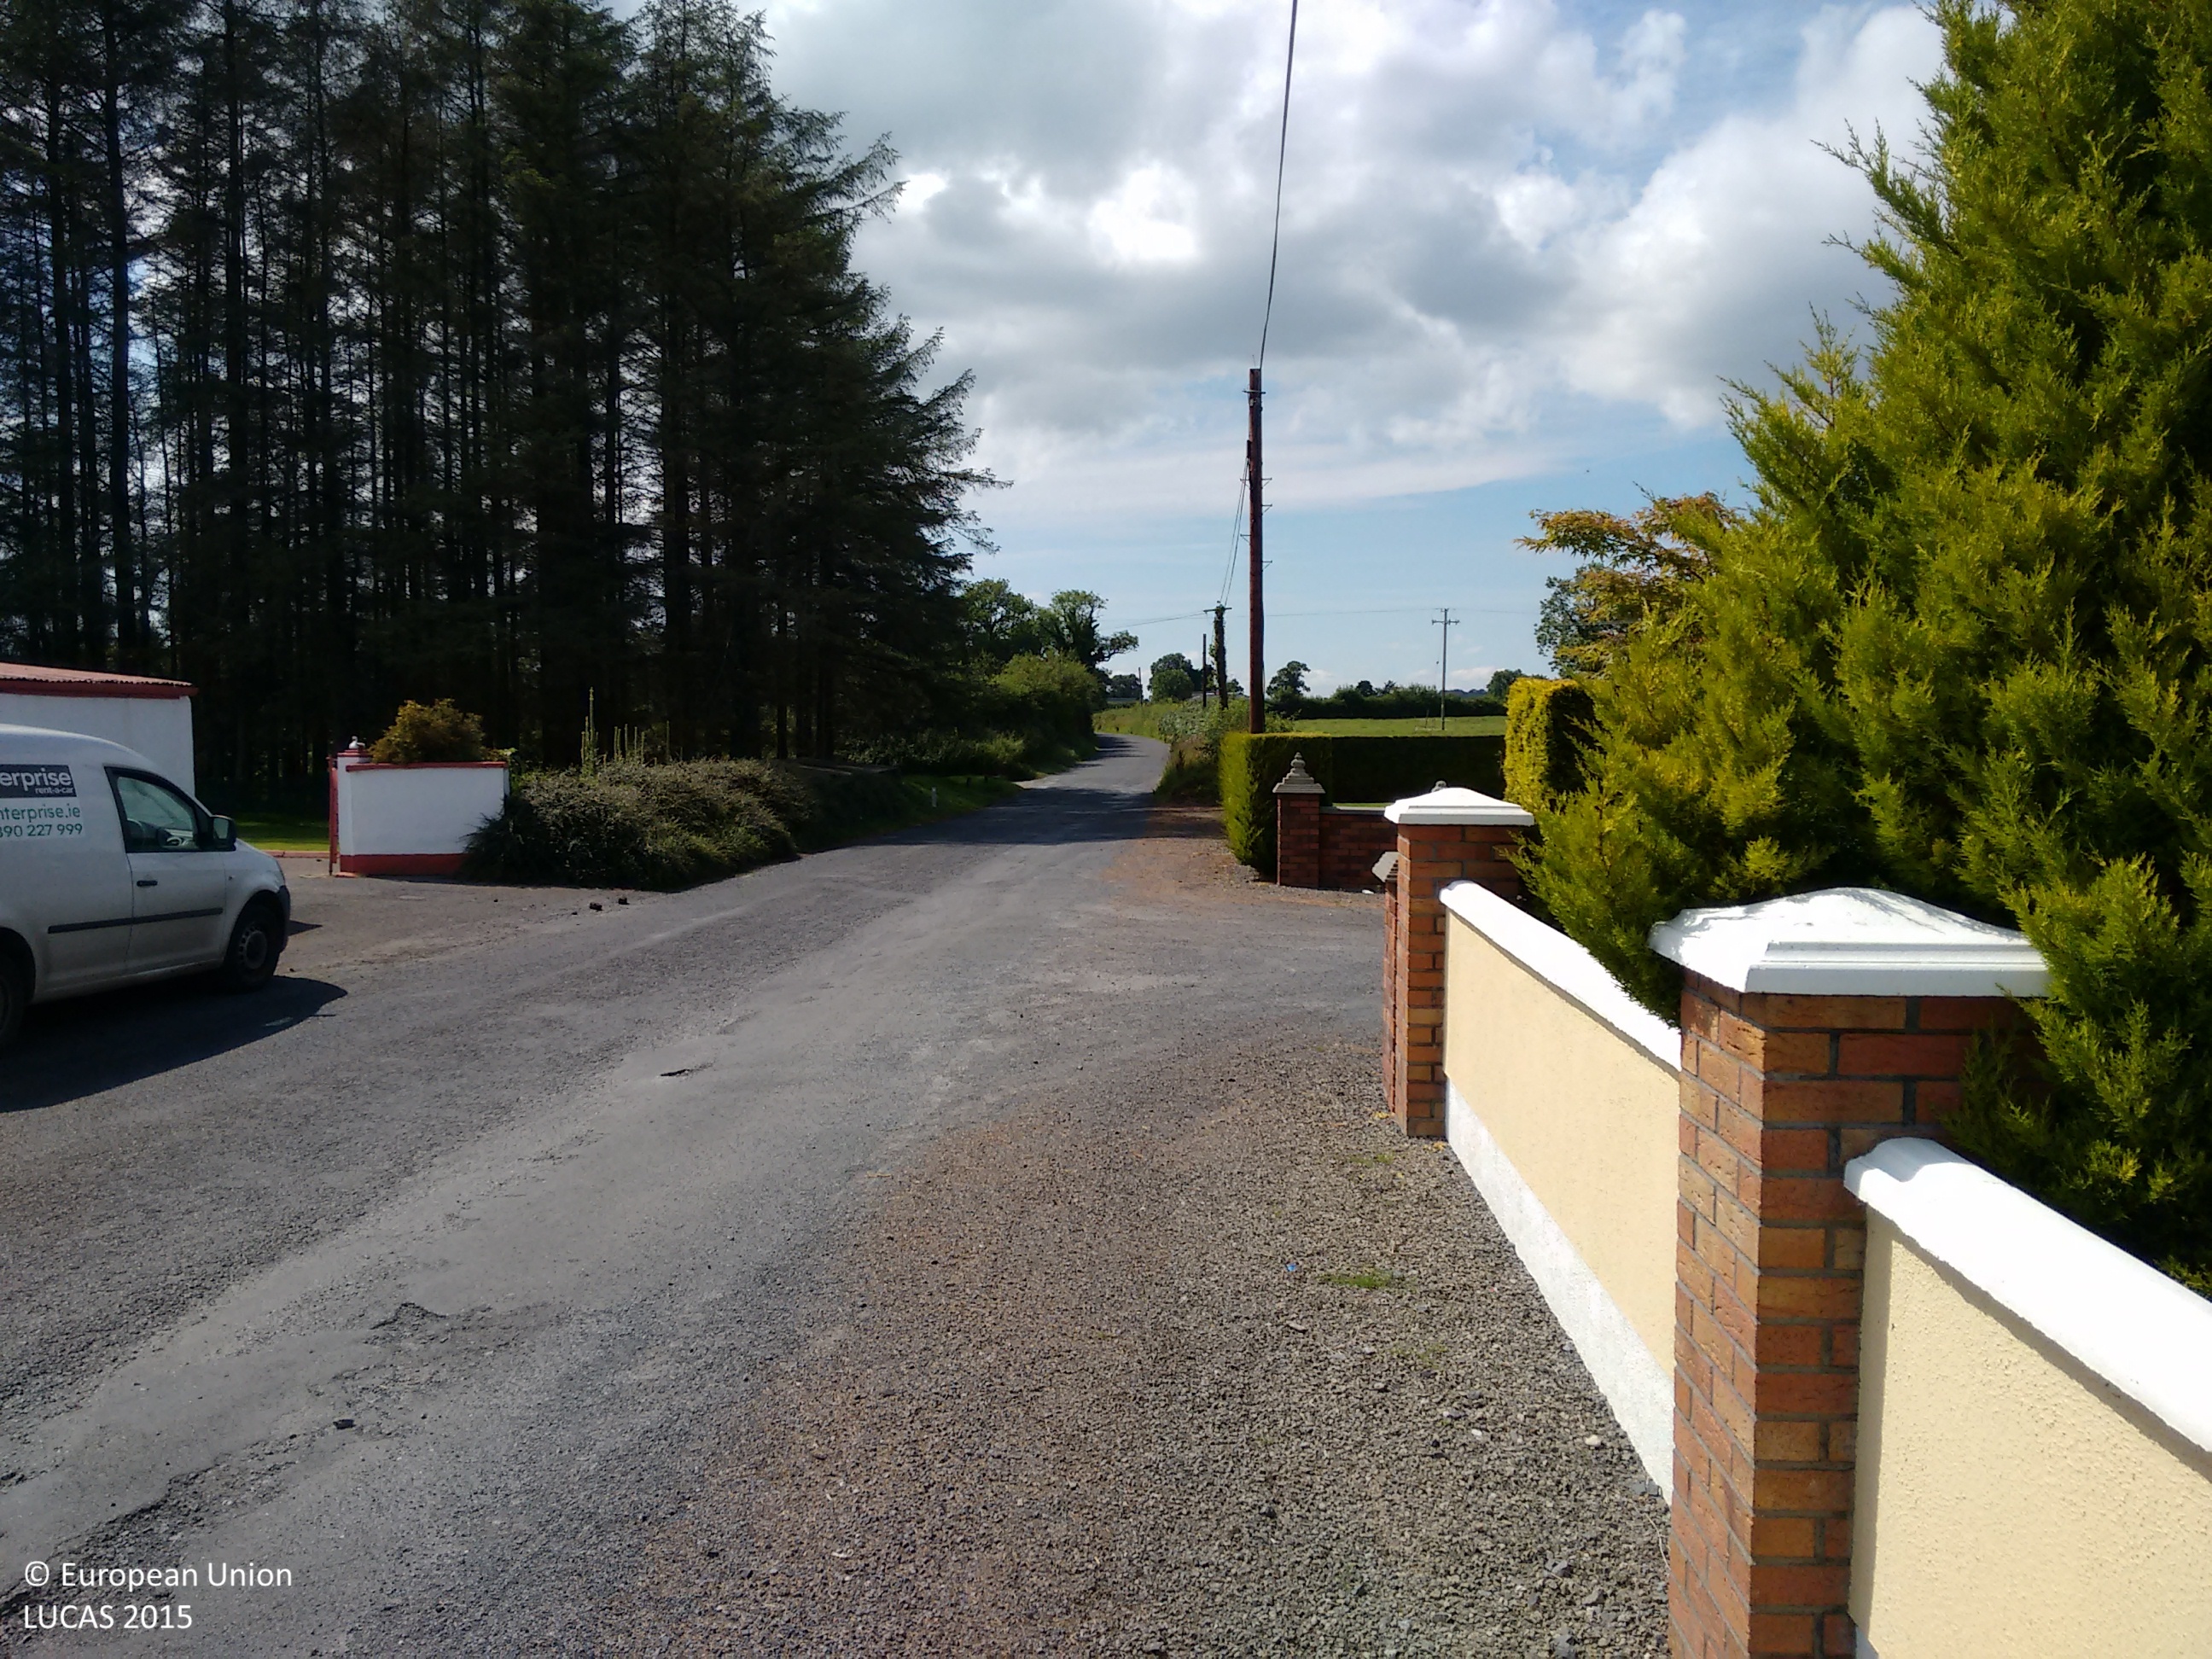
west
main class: Grassland
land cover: Grassland with sparse tree/shrub cover
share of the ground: > 75 %
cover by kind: herbaceous plants 90 %, broadleaved forest trees 5 %, shrubs 5 %
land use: Residential
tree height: < 5 m
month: August
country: IE
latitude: 52.9990
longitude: -7.4872
